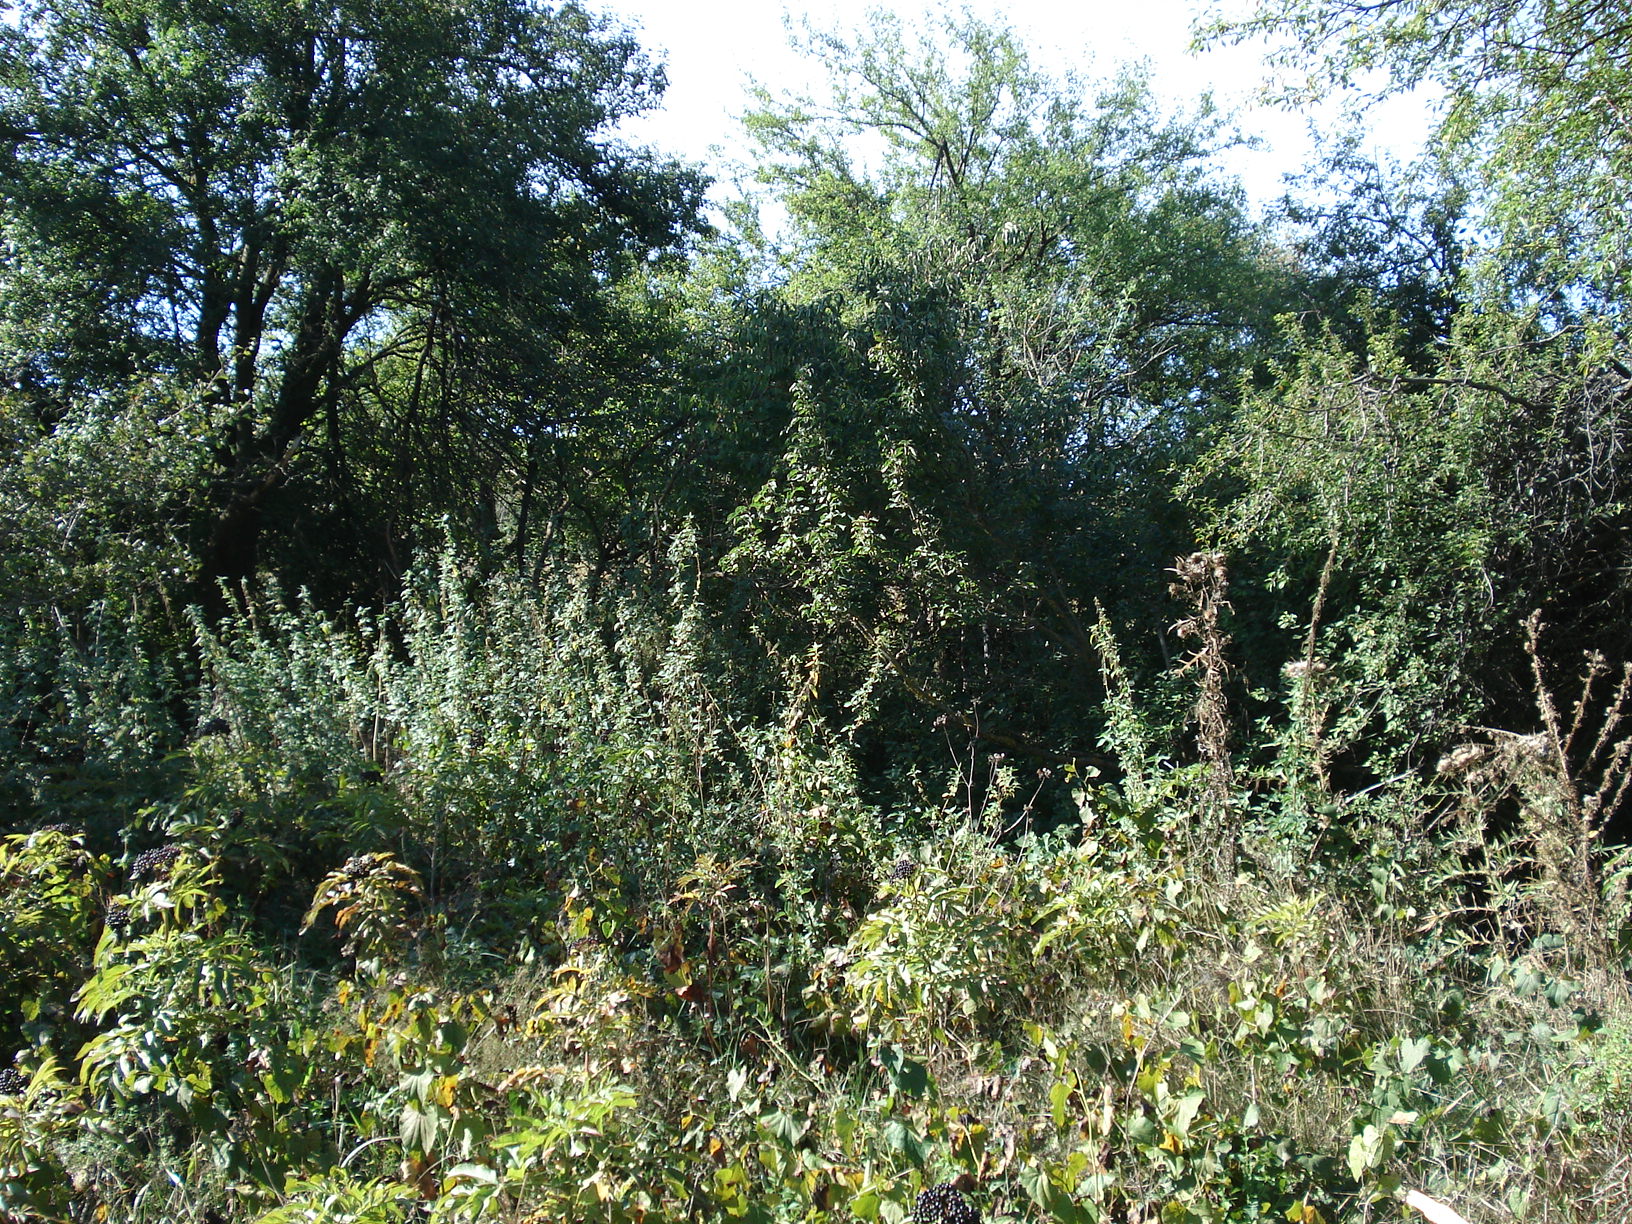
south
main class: Woodland
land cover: Broadleaved woodland
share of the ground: 50 - 75 %
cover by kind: broadleaved forest trees 65 %, herbaceous plants 30 %, shrubs 5 %
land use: Semi-natural and natural areas not in use
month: September
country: BG
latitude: 43.0978
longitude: 25.4210
